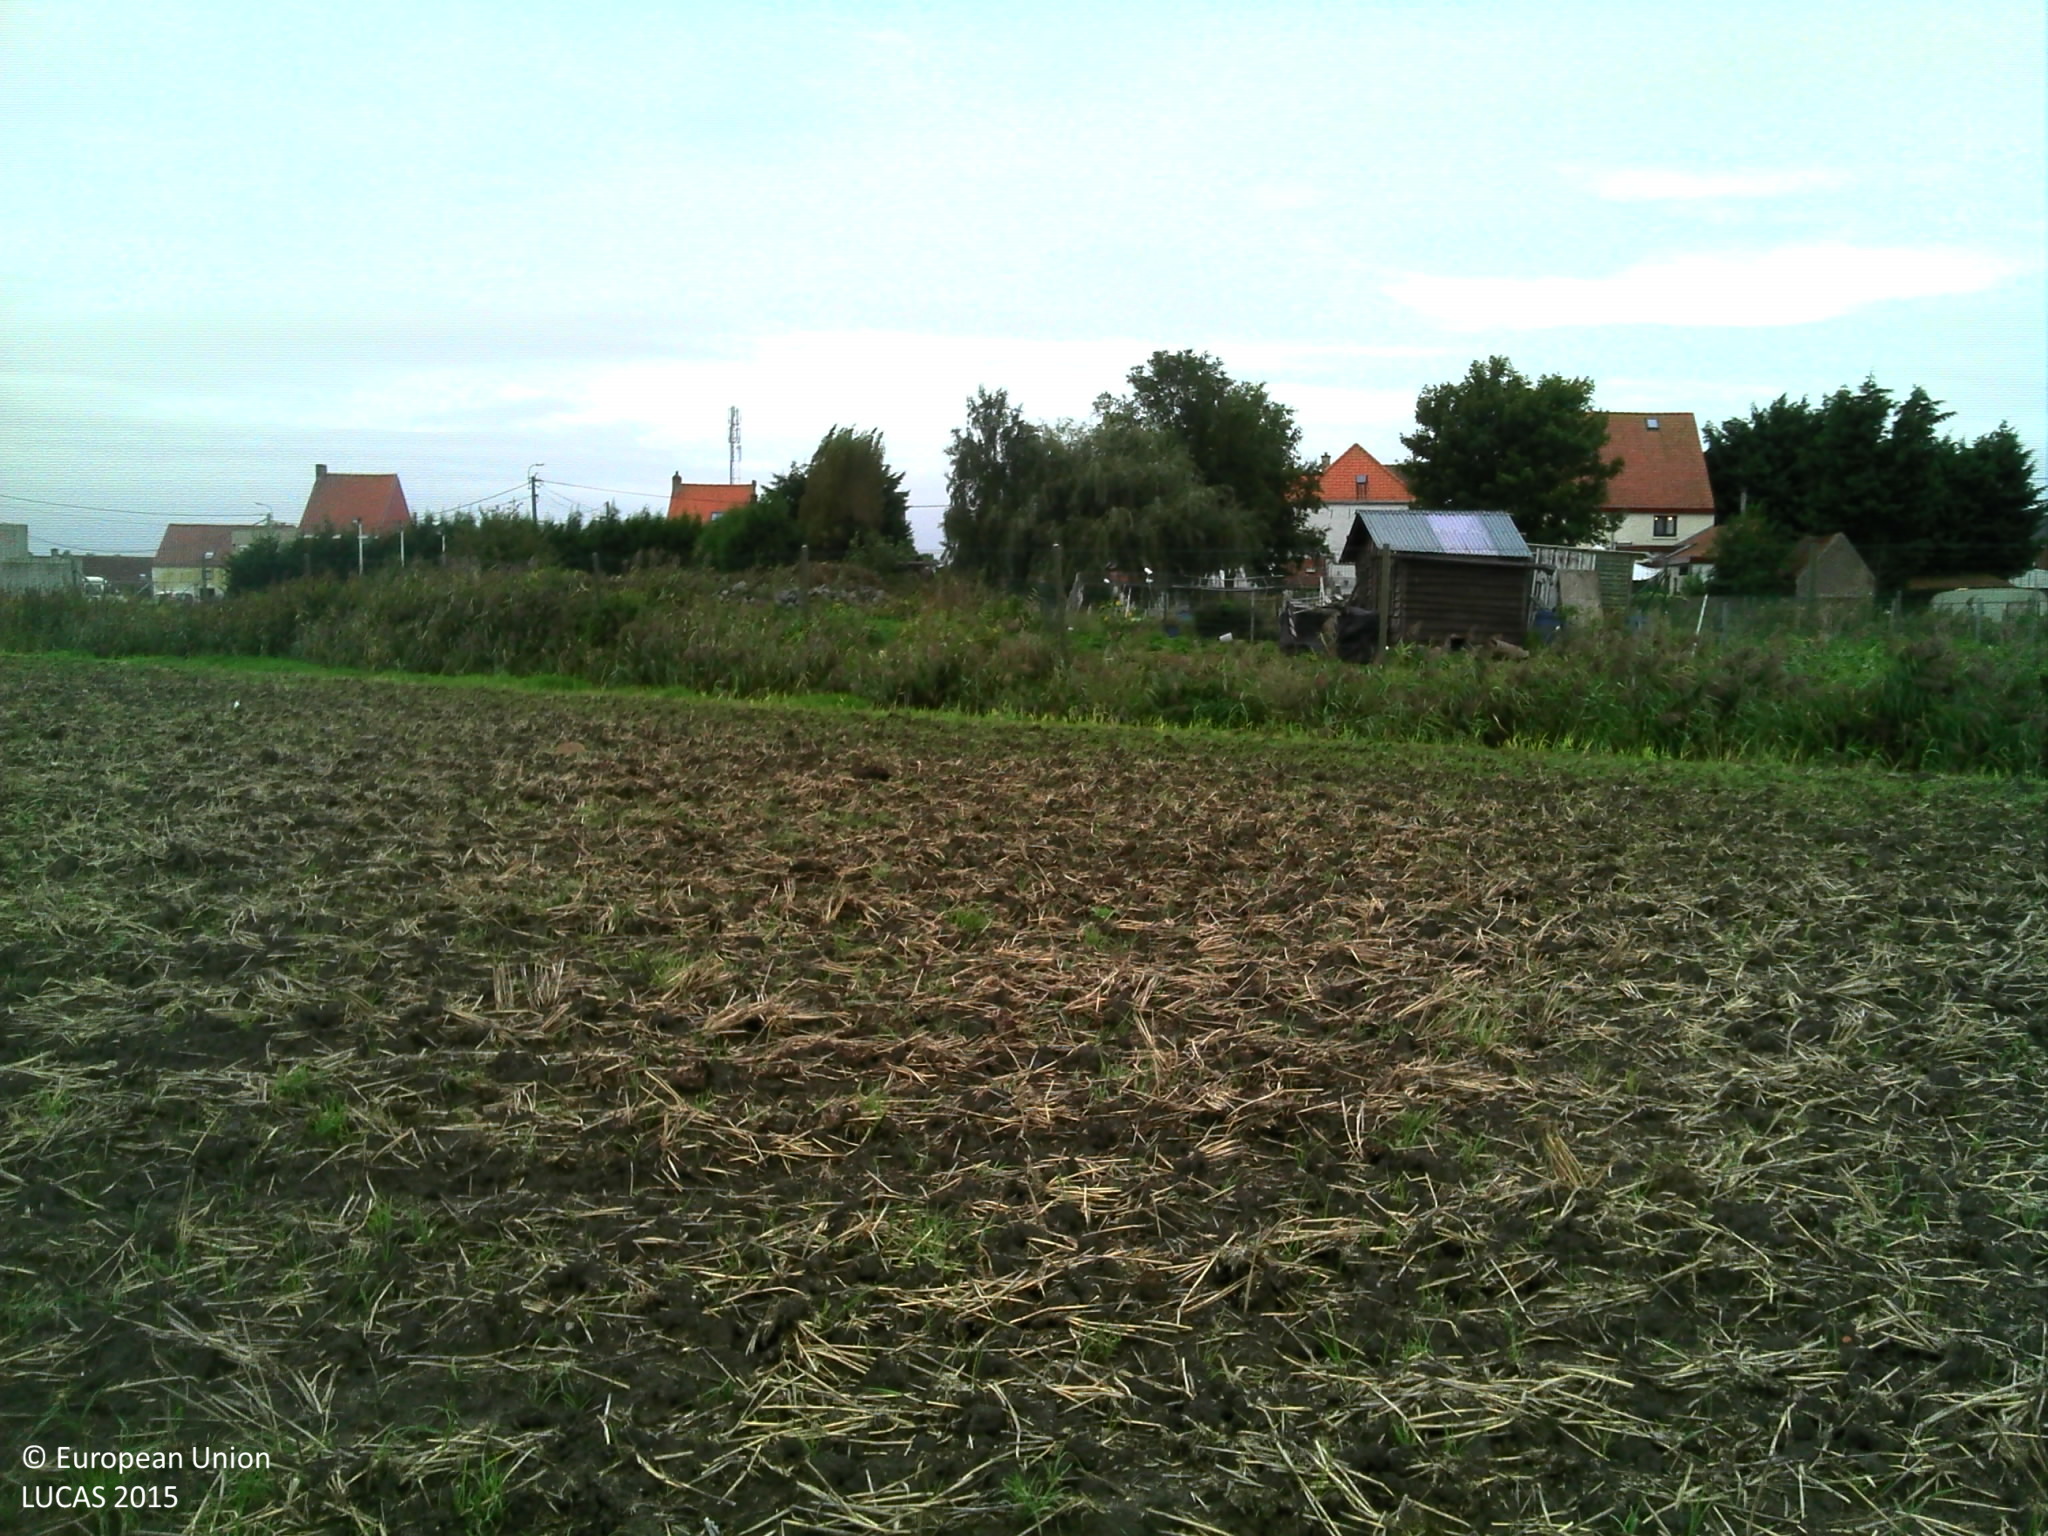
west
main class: Cropland
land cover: Common wheat
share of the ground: 25 - 50 %
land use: Agriculture (excluding fallow land and kitchen gardens)
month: September
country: BE
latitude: 51.1710
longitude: 2.8809
